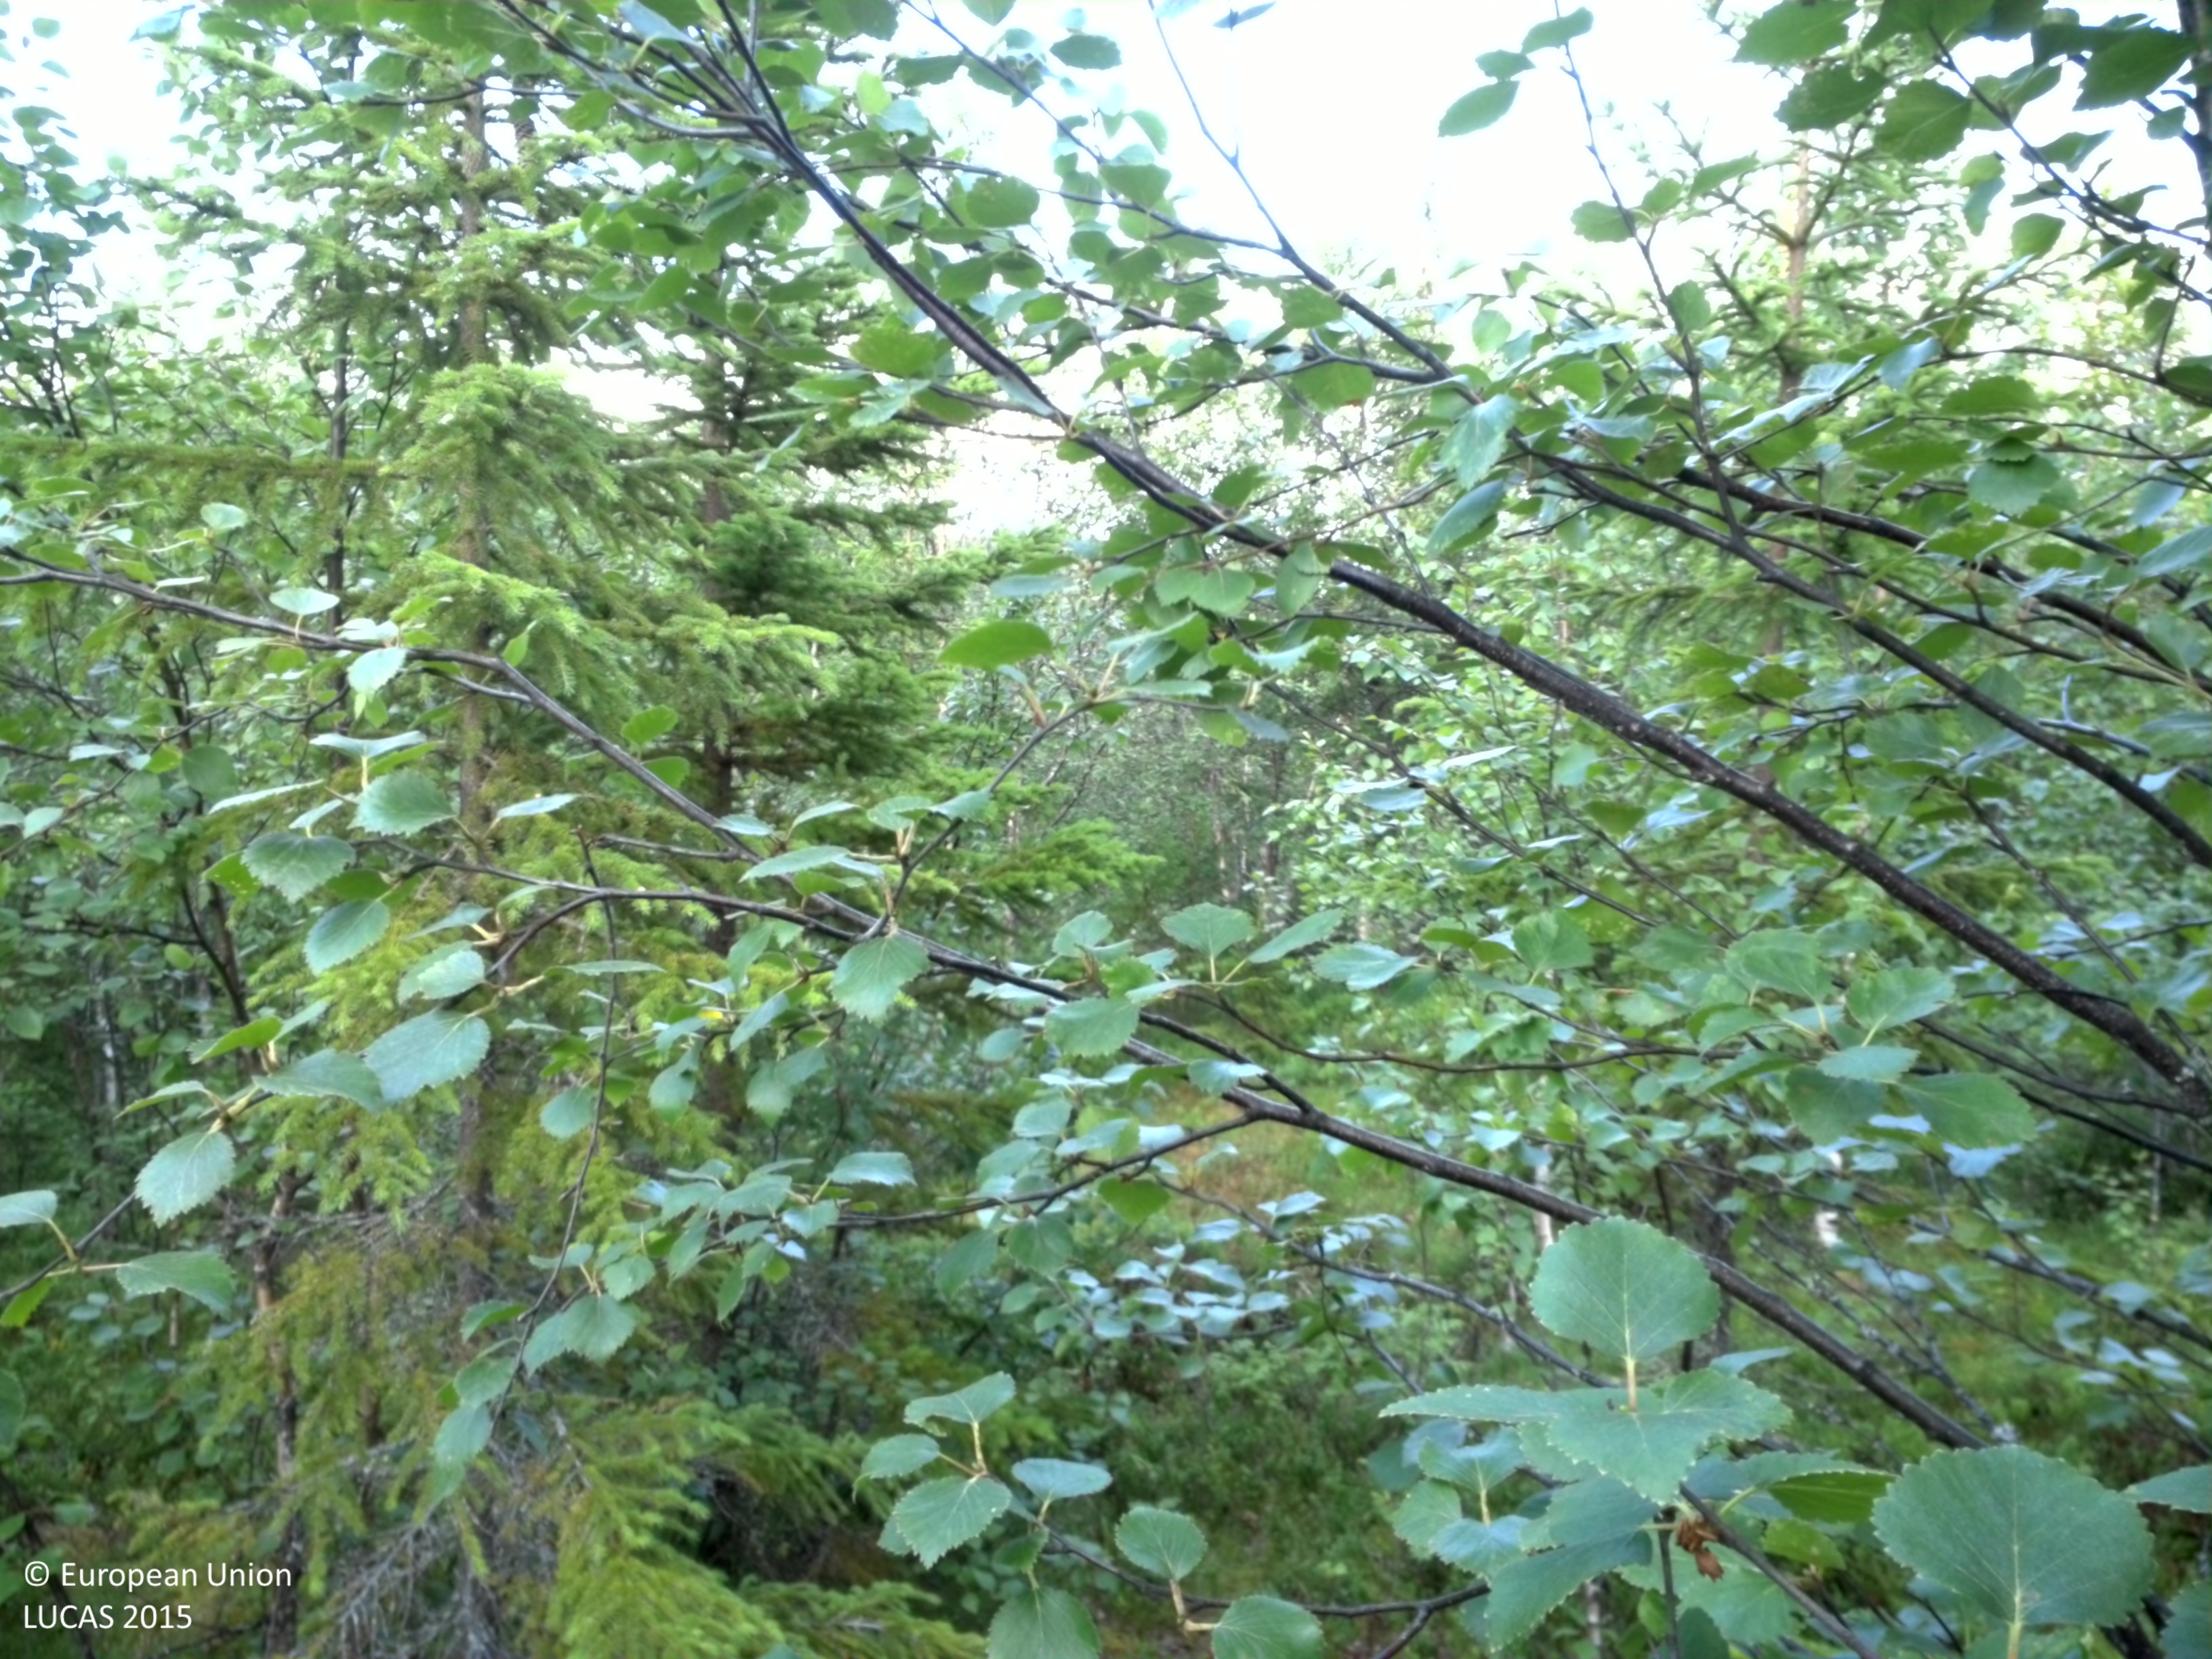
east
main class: Woodland
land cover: Spruce dominated mixed woodland
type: boreal forest
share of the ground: 25 - 50 %
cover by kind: shrubs 55 %, broadleaved forest trees 25 %, coniferous forest trees 10 %, herbaceous plants 5 %, lichens and mosses 5 %
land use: Forestry
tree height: > 5 m
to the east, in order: Spruce dominated mixed woodland; Broadleaved woodland; Rivers and streams; Broadleaved woodland; Shrubland with sparse tree cover; Tracks; Shruby margins; Ditches and canals; Broadleaved woodland; Spruce dominated mixed woodland
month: August
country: SE
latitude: 64.8621
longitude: 16.0638
